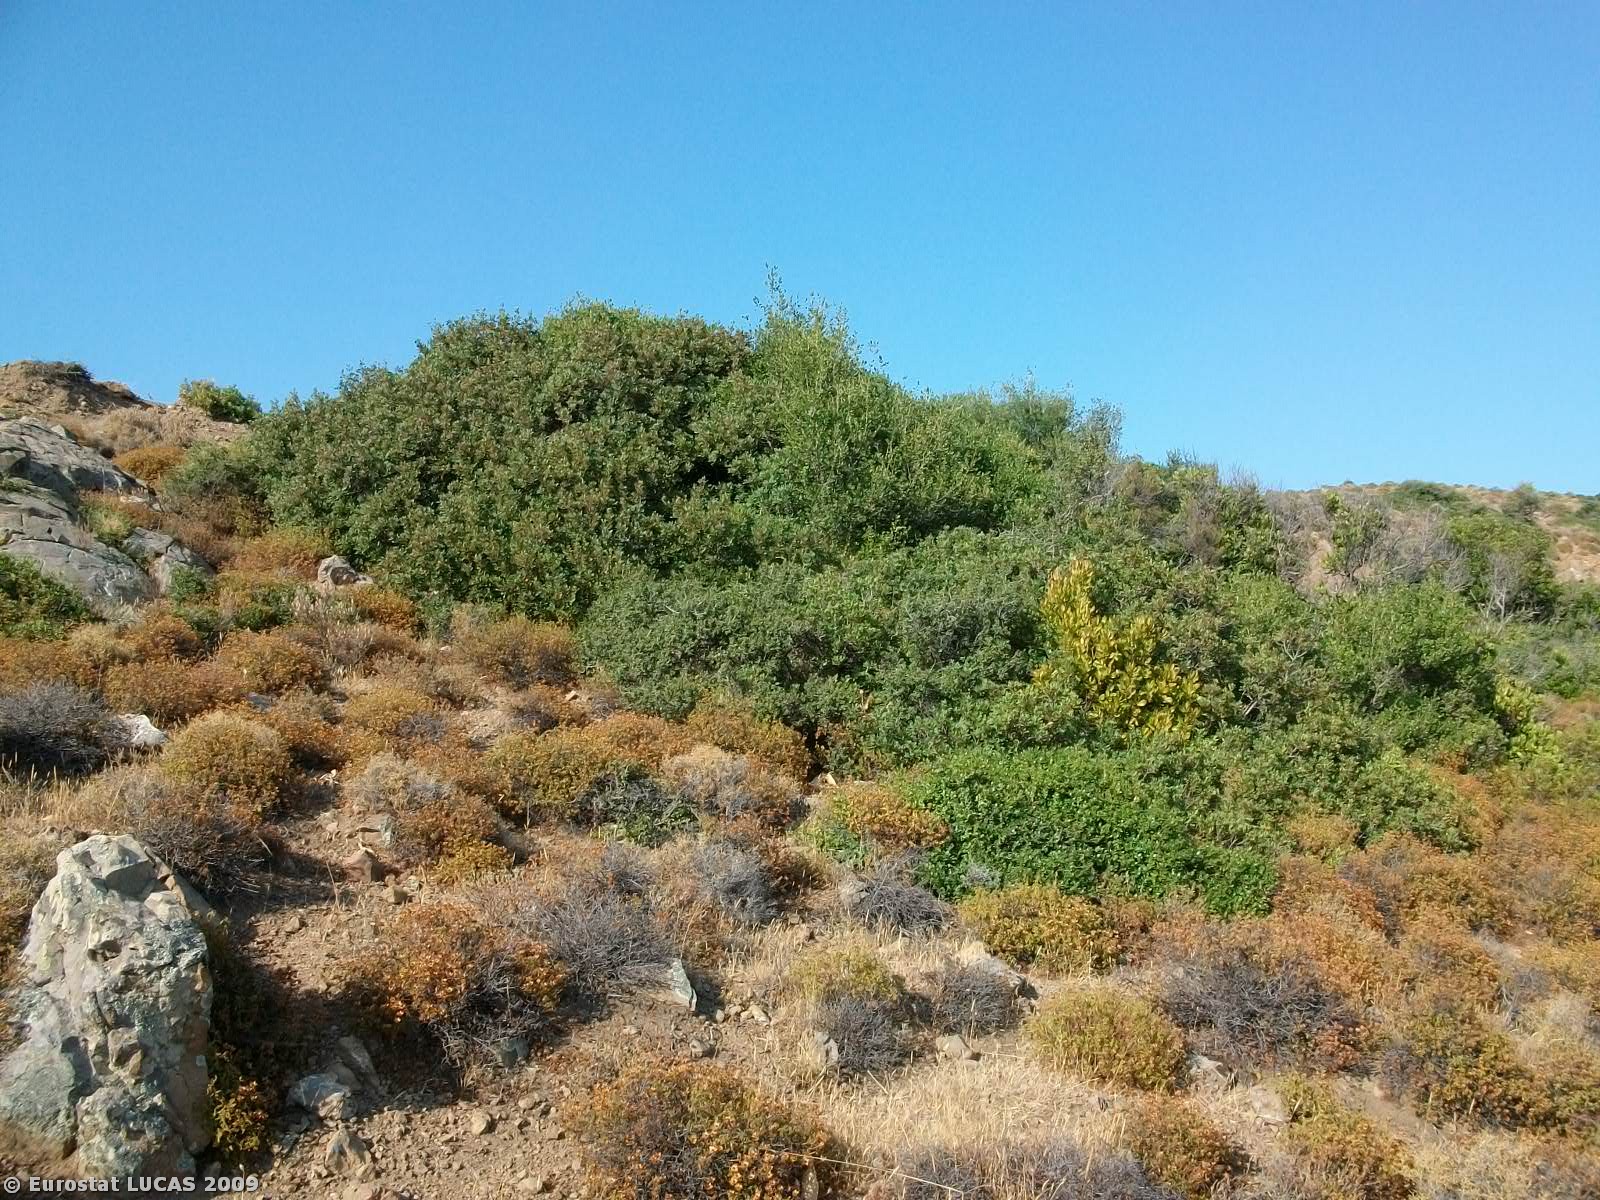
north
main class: Shrubland
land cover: Shrubland without tree cover
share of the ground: > 75 %
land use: Unused
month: August
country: GR
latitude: 37.4664
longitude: 23.3216
